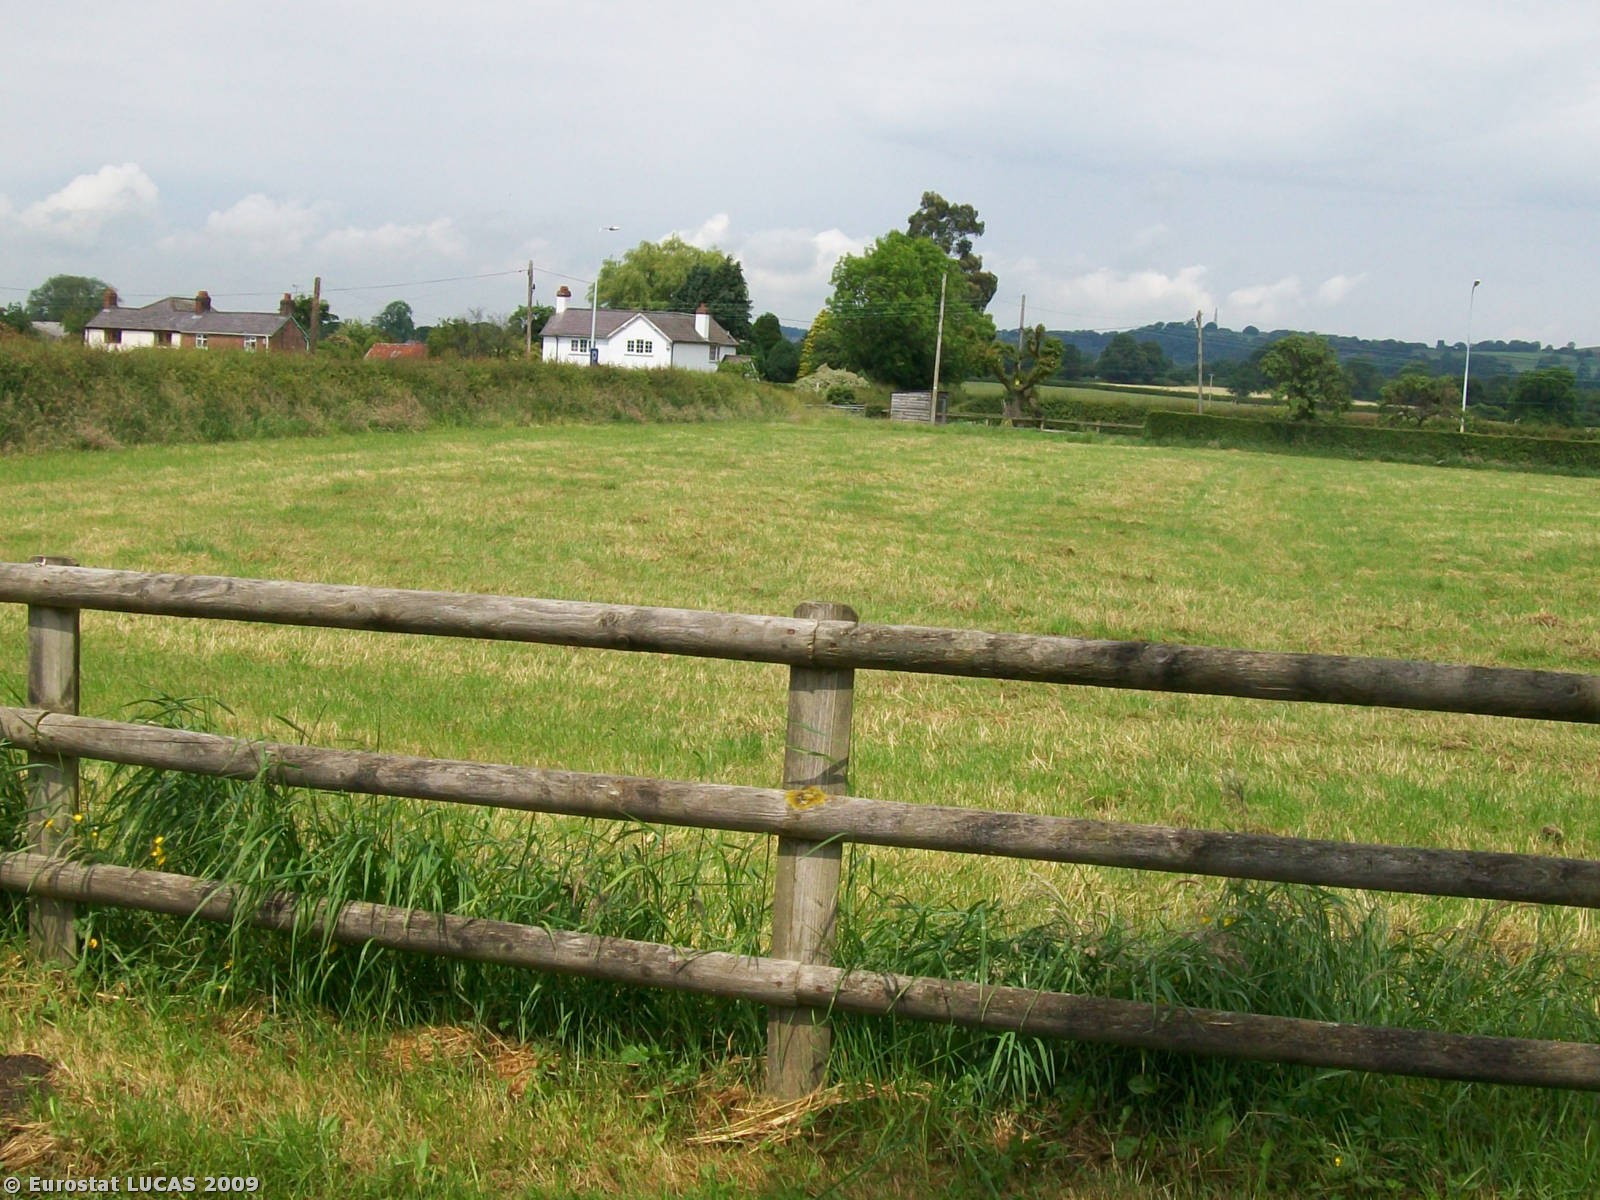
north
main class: Grassland
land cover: Grassland without tree/shrub cover
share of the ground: > 75 %
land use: Agriculture (excluding fallow land and kitchen gardens)
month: June
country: GB
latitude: 53.1659
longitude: -2.7089
